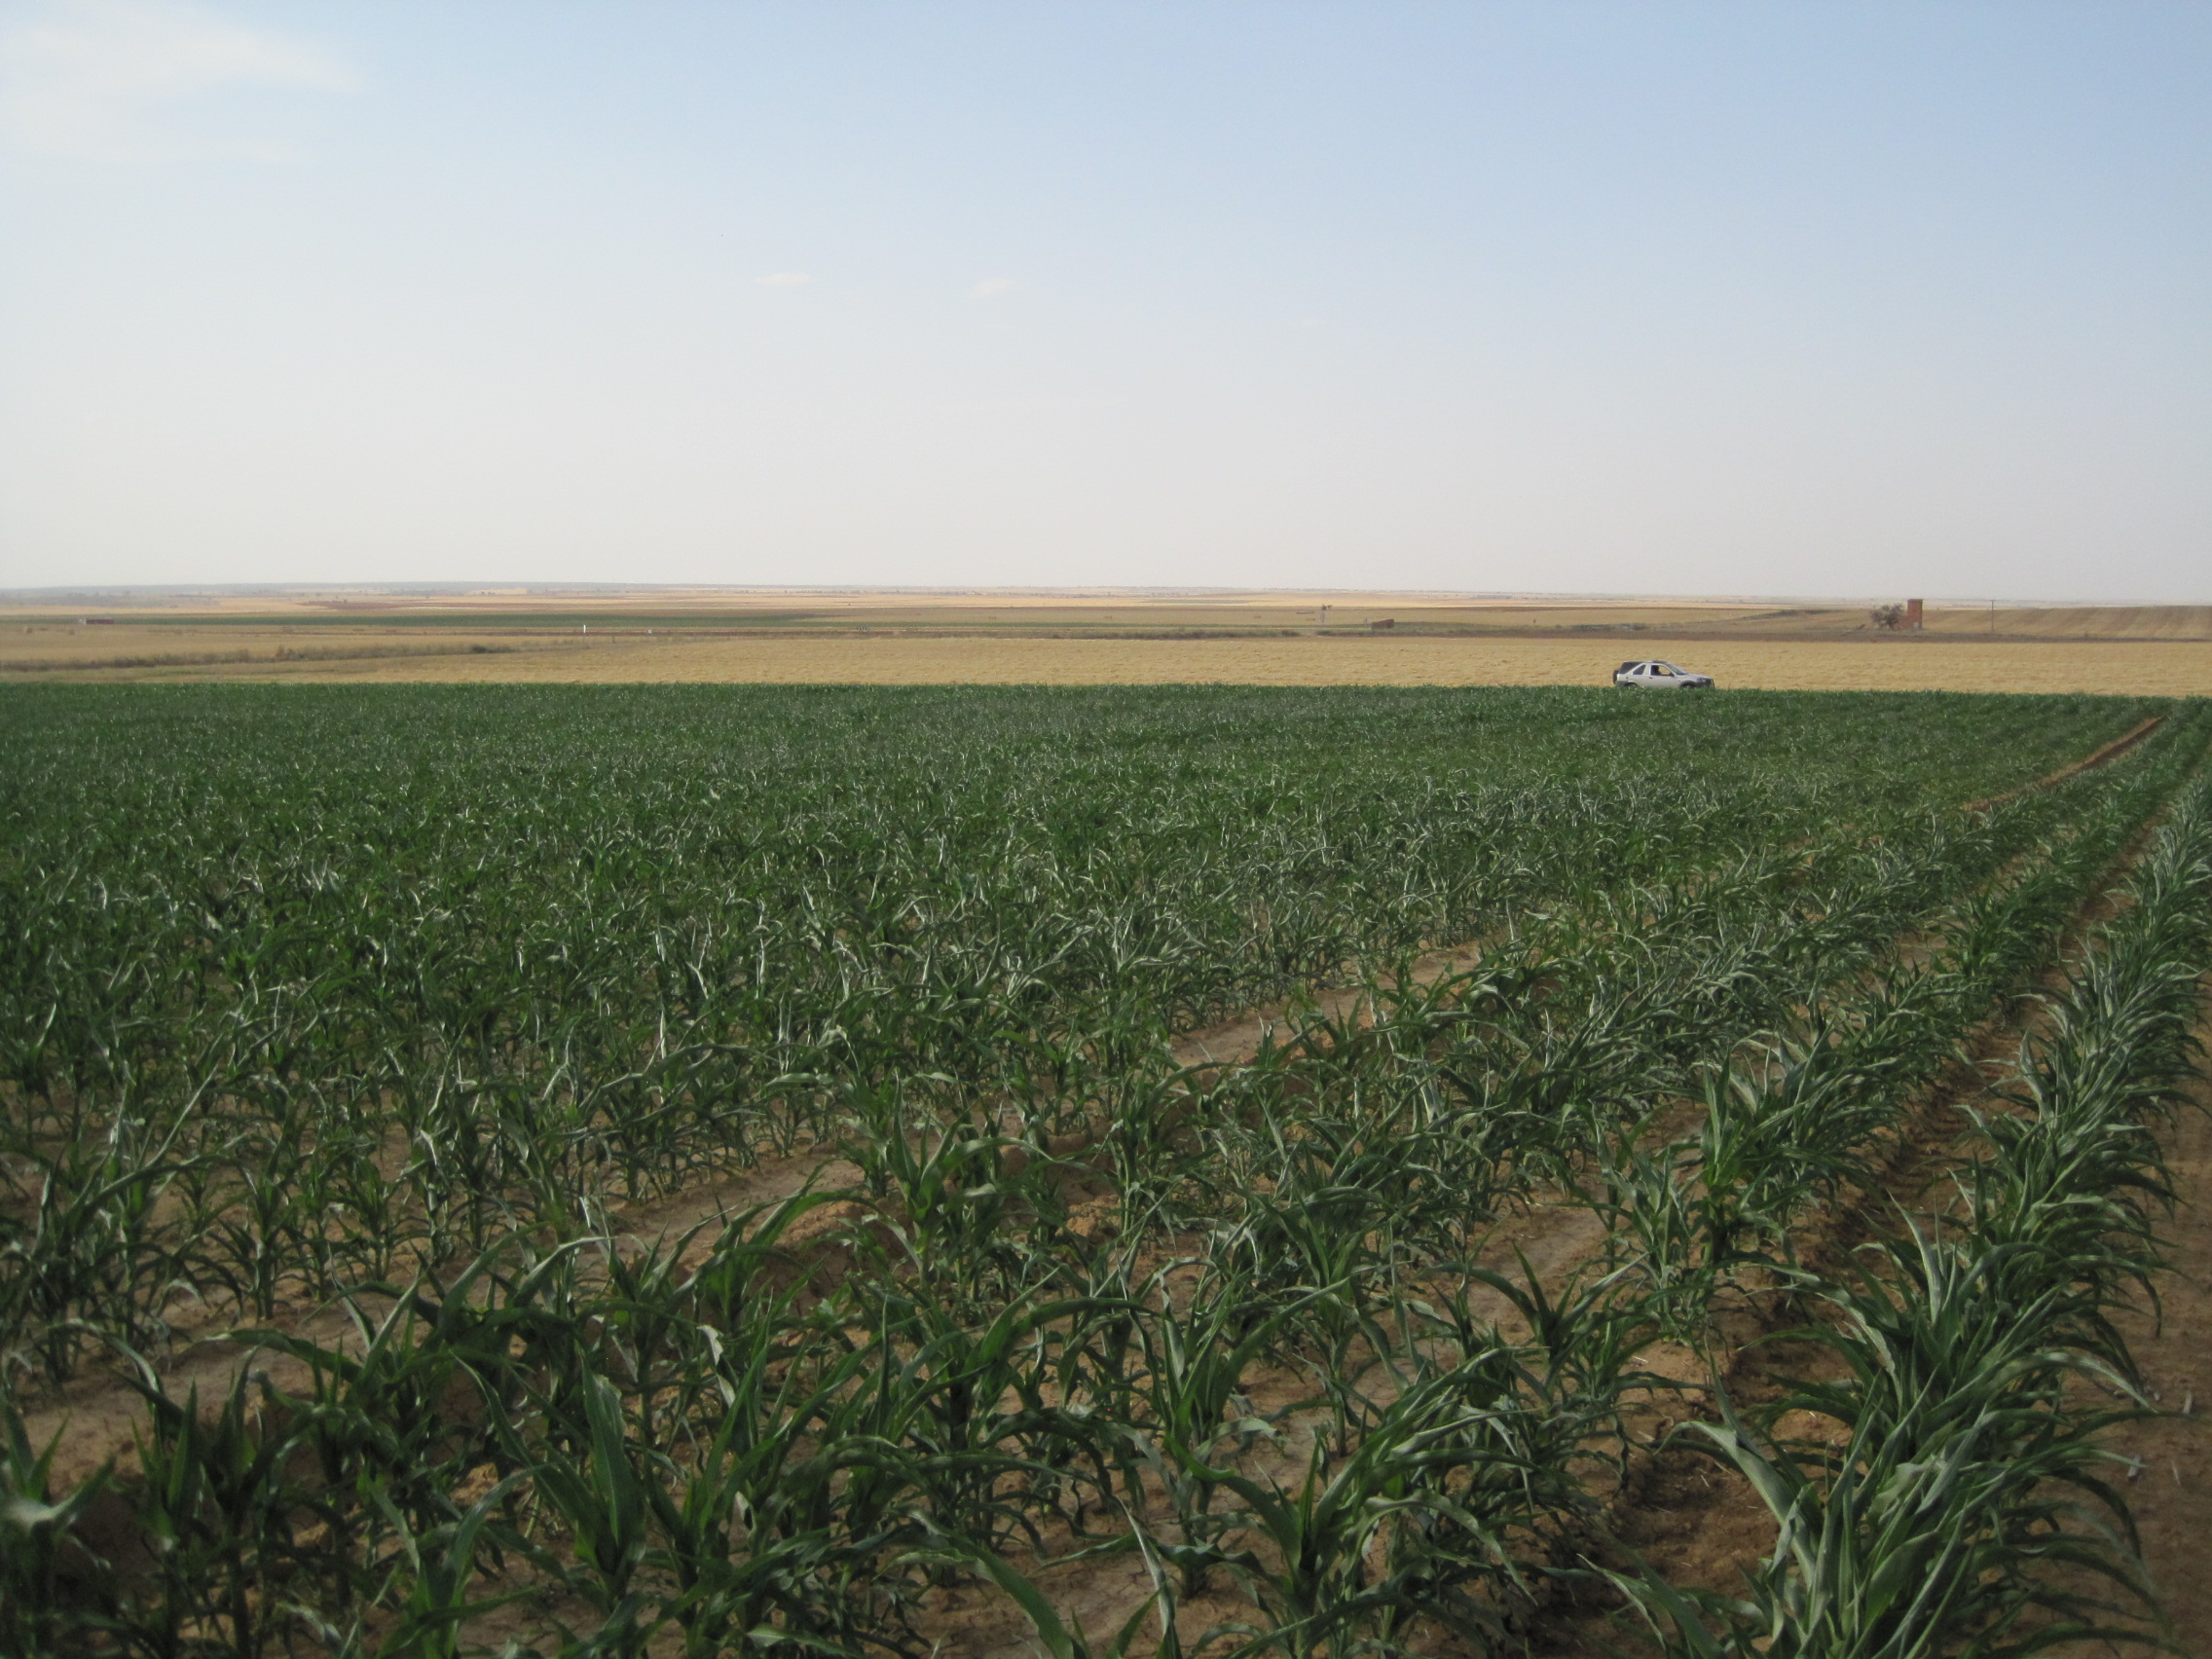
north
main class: Cropland
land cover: Maize
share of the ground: > 75 %
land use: Agriculture (excluding fallow land and kitchen gardens)
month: July
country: ES
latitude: 41.6780
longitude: -5.3487
